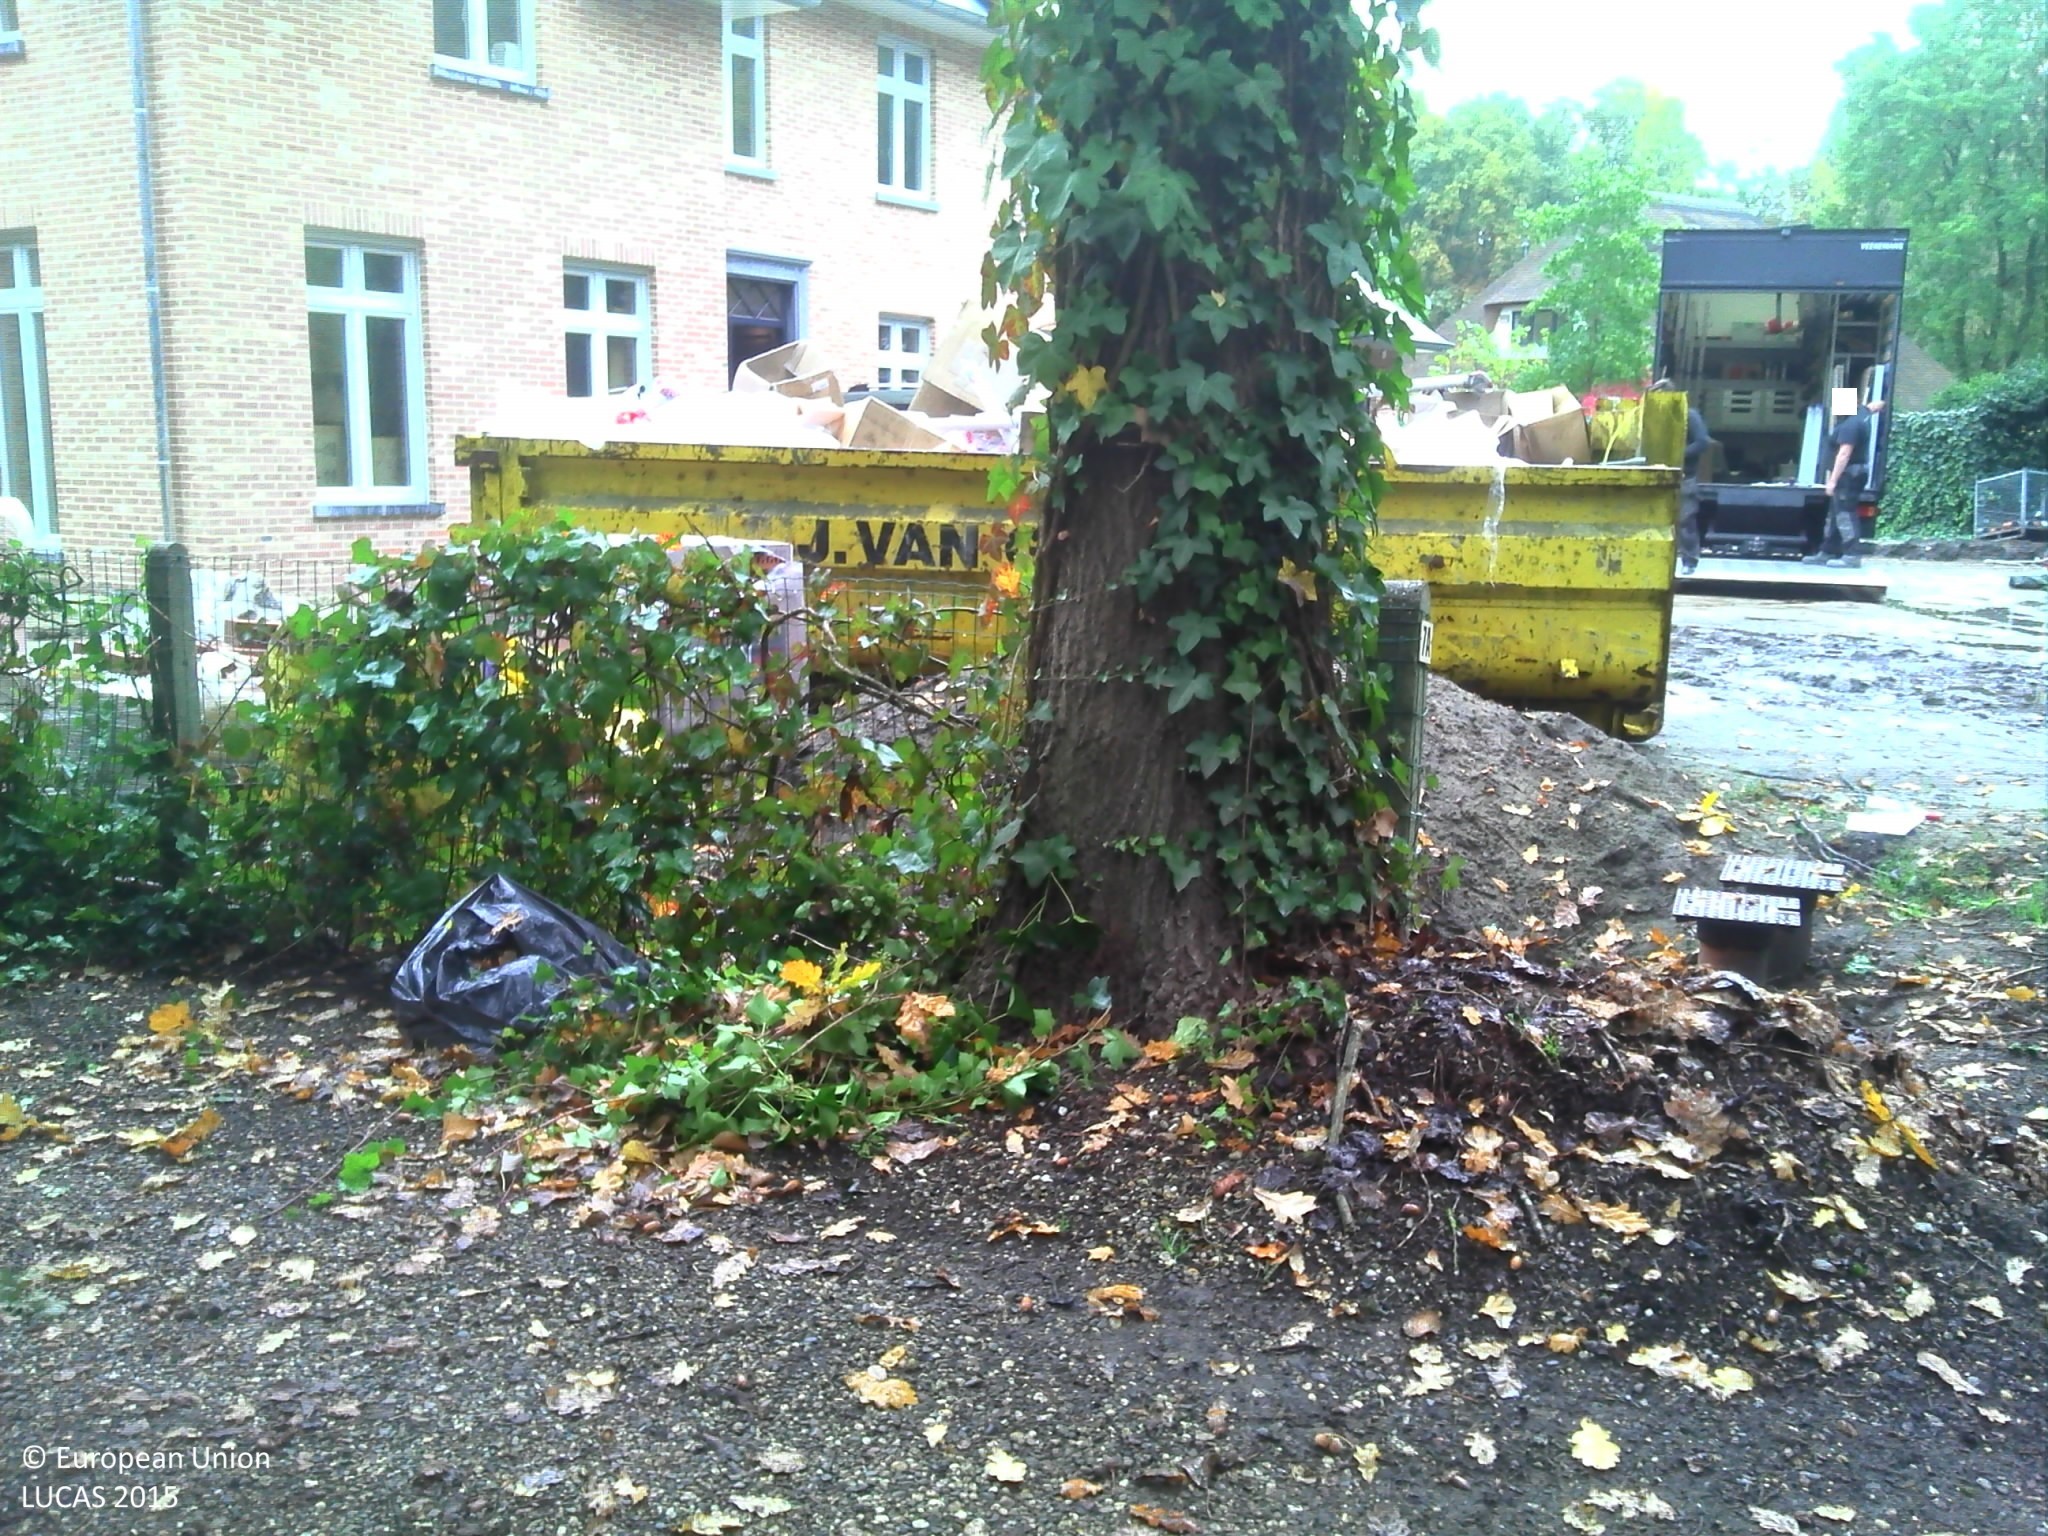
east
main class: Woodland
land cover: Other mixed woodland
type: exotic forest
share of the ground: > 75 %
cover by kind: broadleaved forest trees 70 %, coniferous forest trees 30 %
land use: Residential
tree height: > 5 m
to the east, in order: Other mixed woodland; Artificial constructions in urban areas; Broadleaved woodland
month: October
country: BE
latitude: 50.9972
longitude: 4.6815
